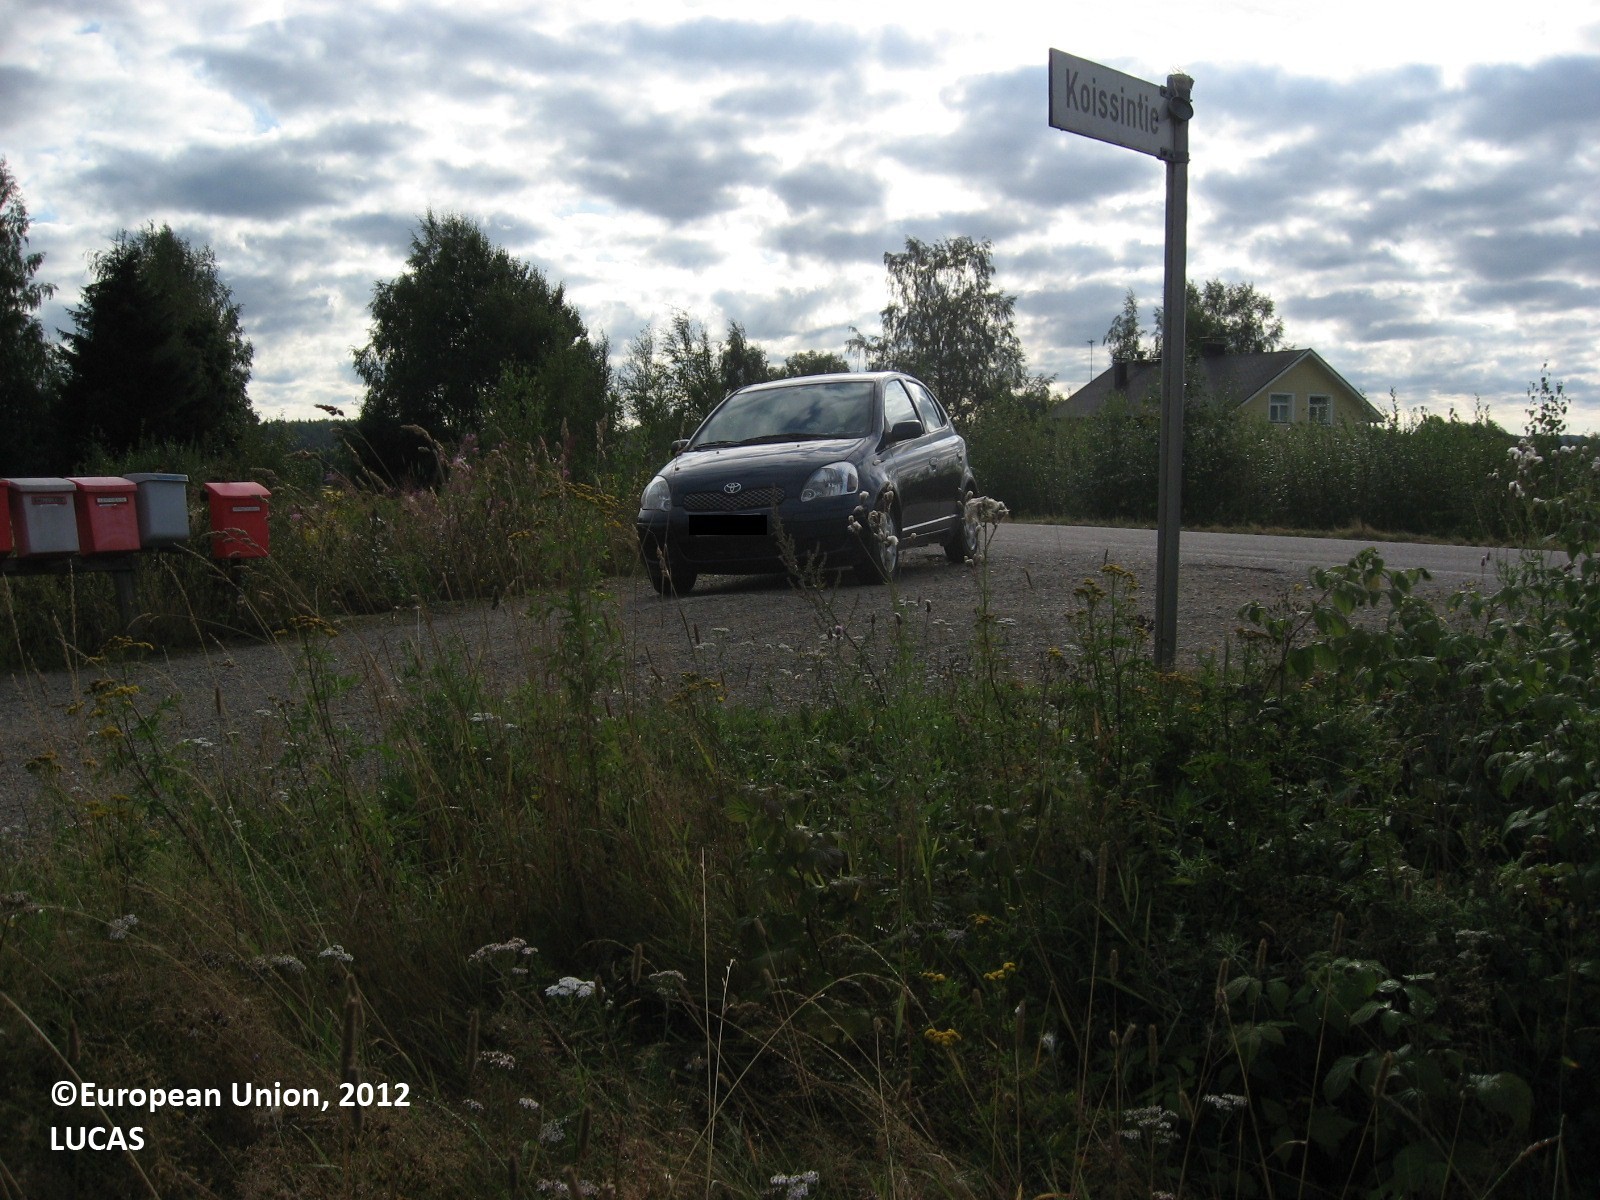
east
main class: Cropland
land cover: Temporary grasslands
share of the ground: > 75 %
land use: Agriculture (excluding fallow land and kitchen gardens)
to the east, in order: Temporary grasslands; Grass margins; Paved roads, cycling and walking lanes; Grass margins; Paved roads, cycling and walking lanes; Grass margins; Ditches and canals; Broadleaved woodland; Artificial constructions in urban areas; Spontaneously vegetated surfaces; Temporary grasslands
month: August
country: FI
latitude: 61.1606
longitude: 24.7705
